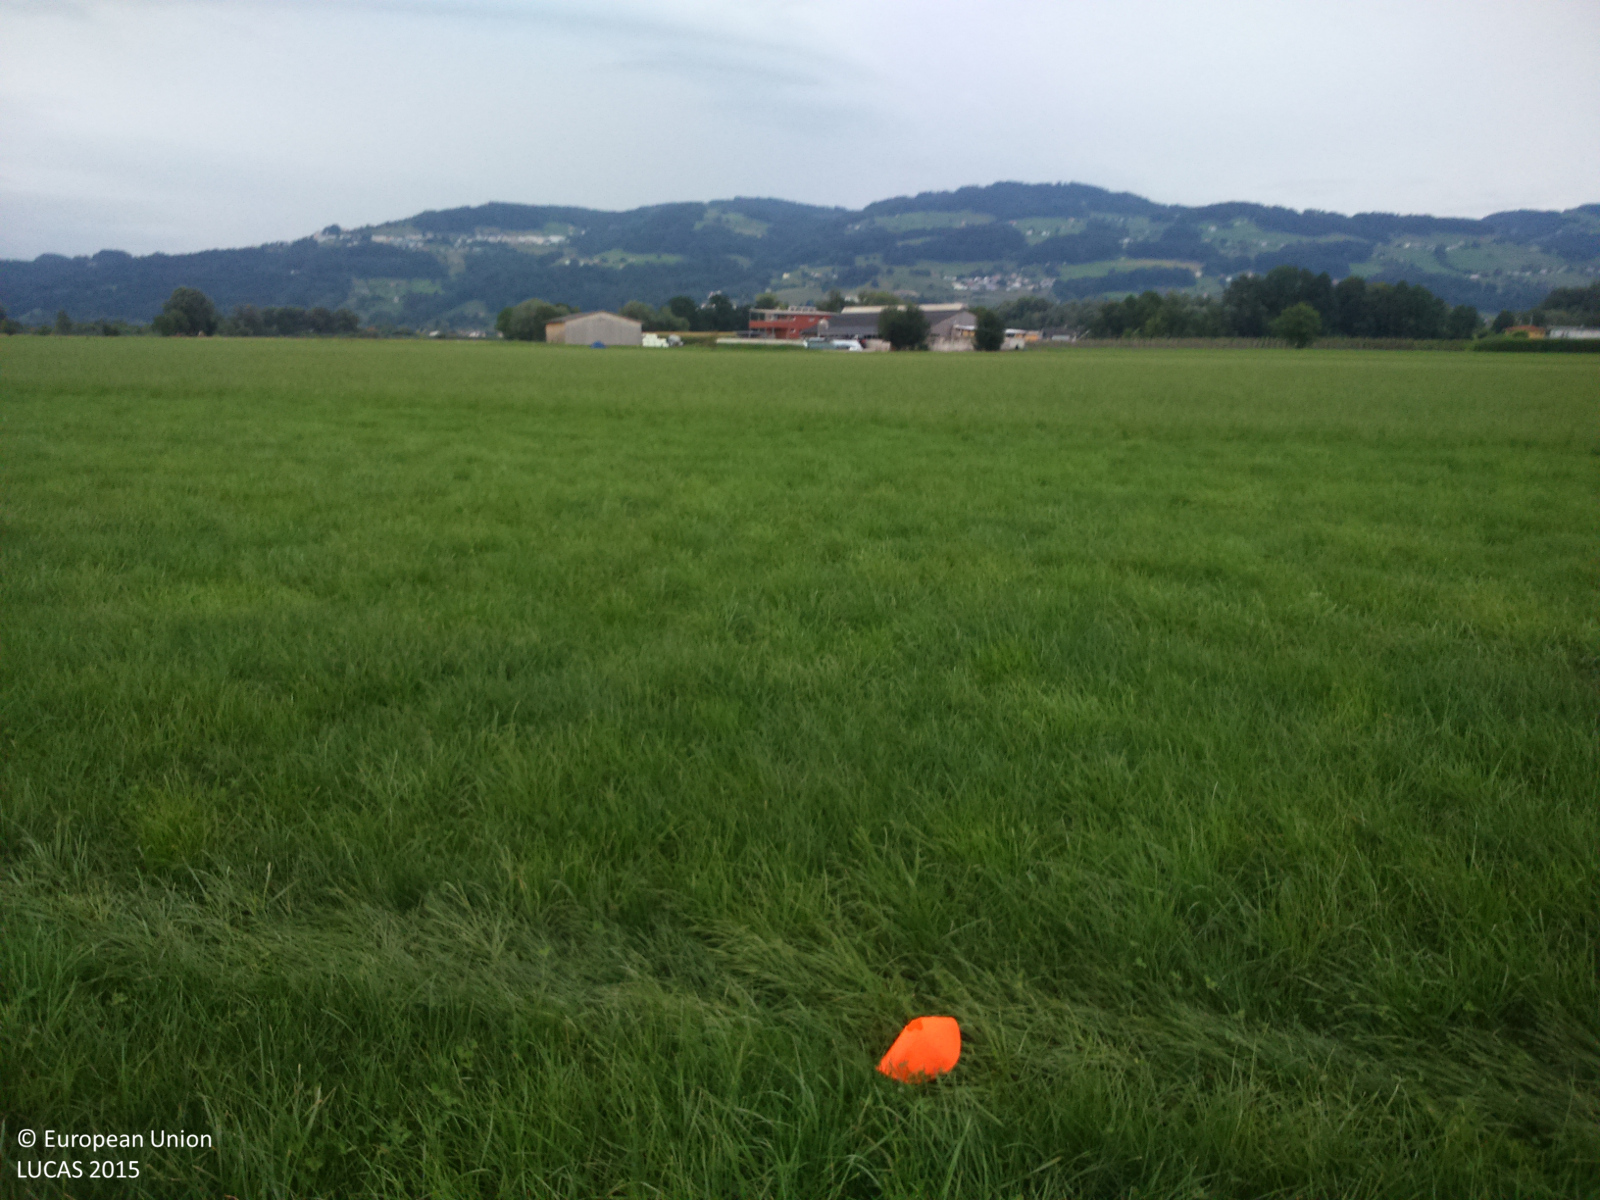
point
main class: Grassland
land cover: Grassland without tree/shrub cover
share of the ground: > 75 %
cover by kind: herbaceous plants 100 %
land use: Agriculture (excluding fallow land and kitchen gardens)
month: August
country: AT
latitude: 47.4848
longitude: 9.5890
